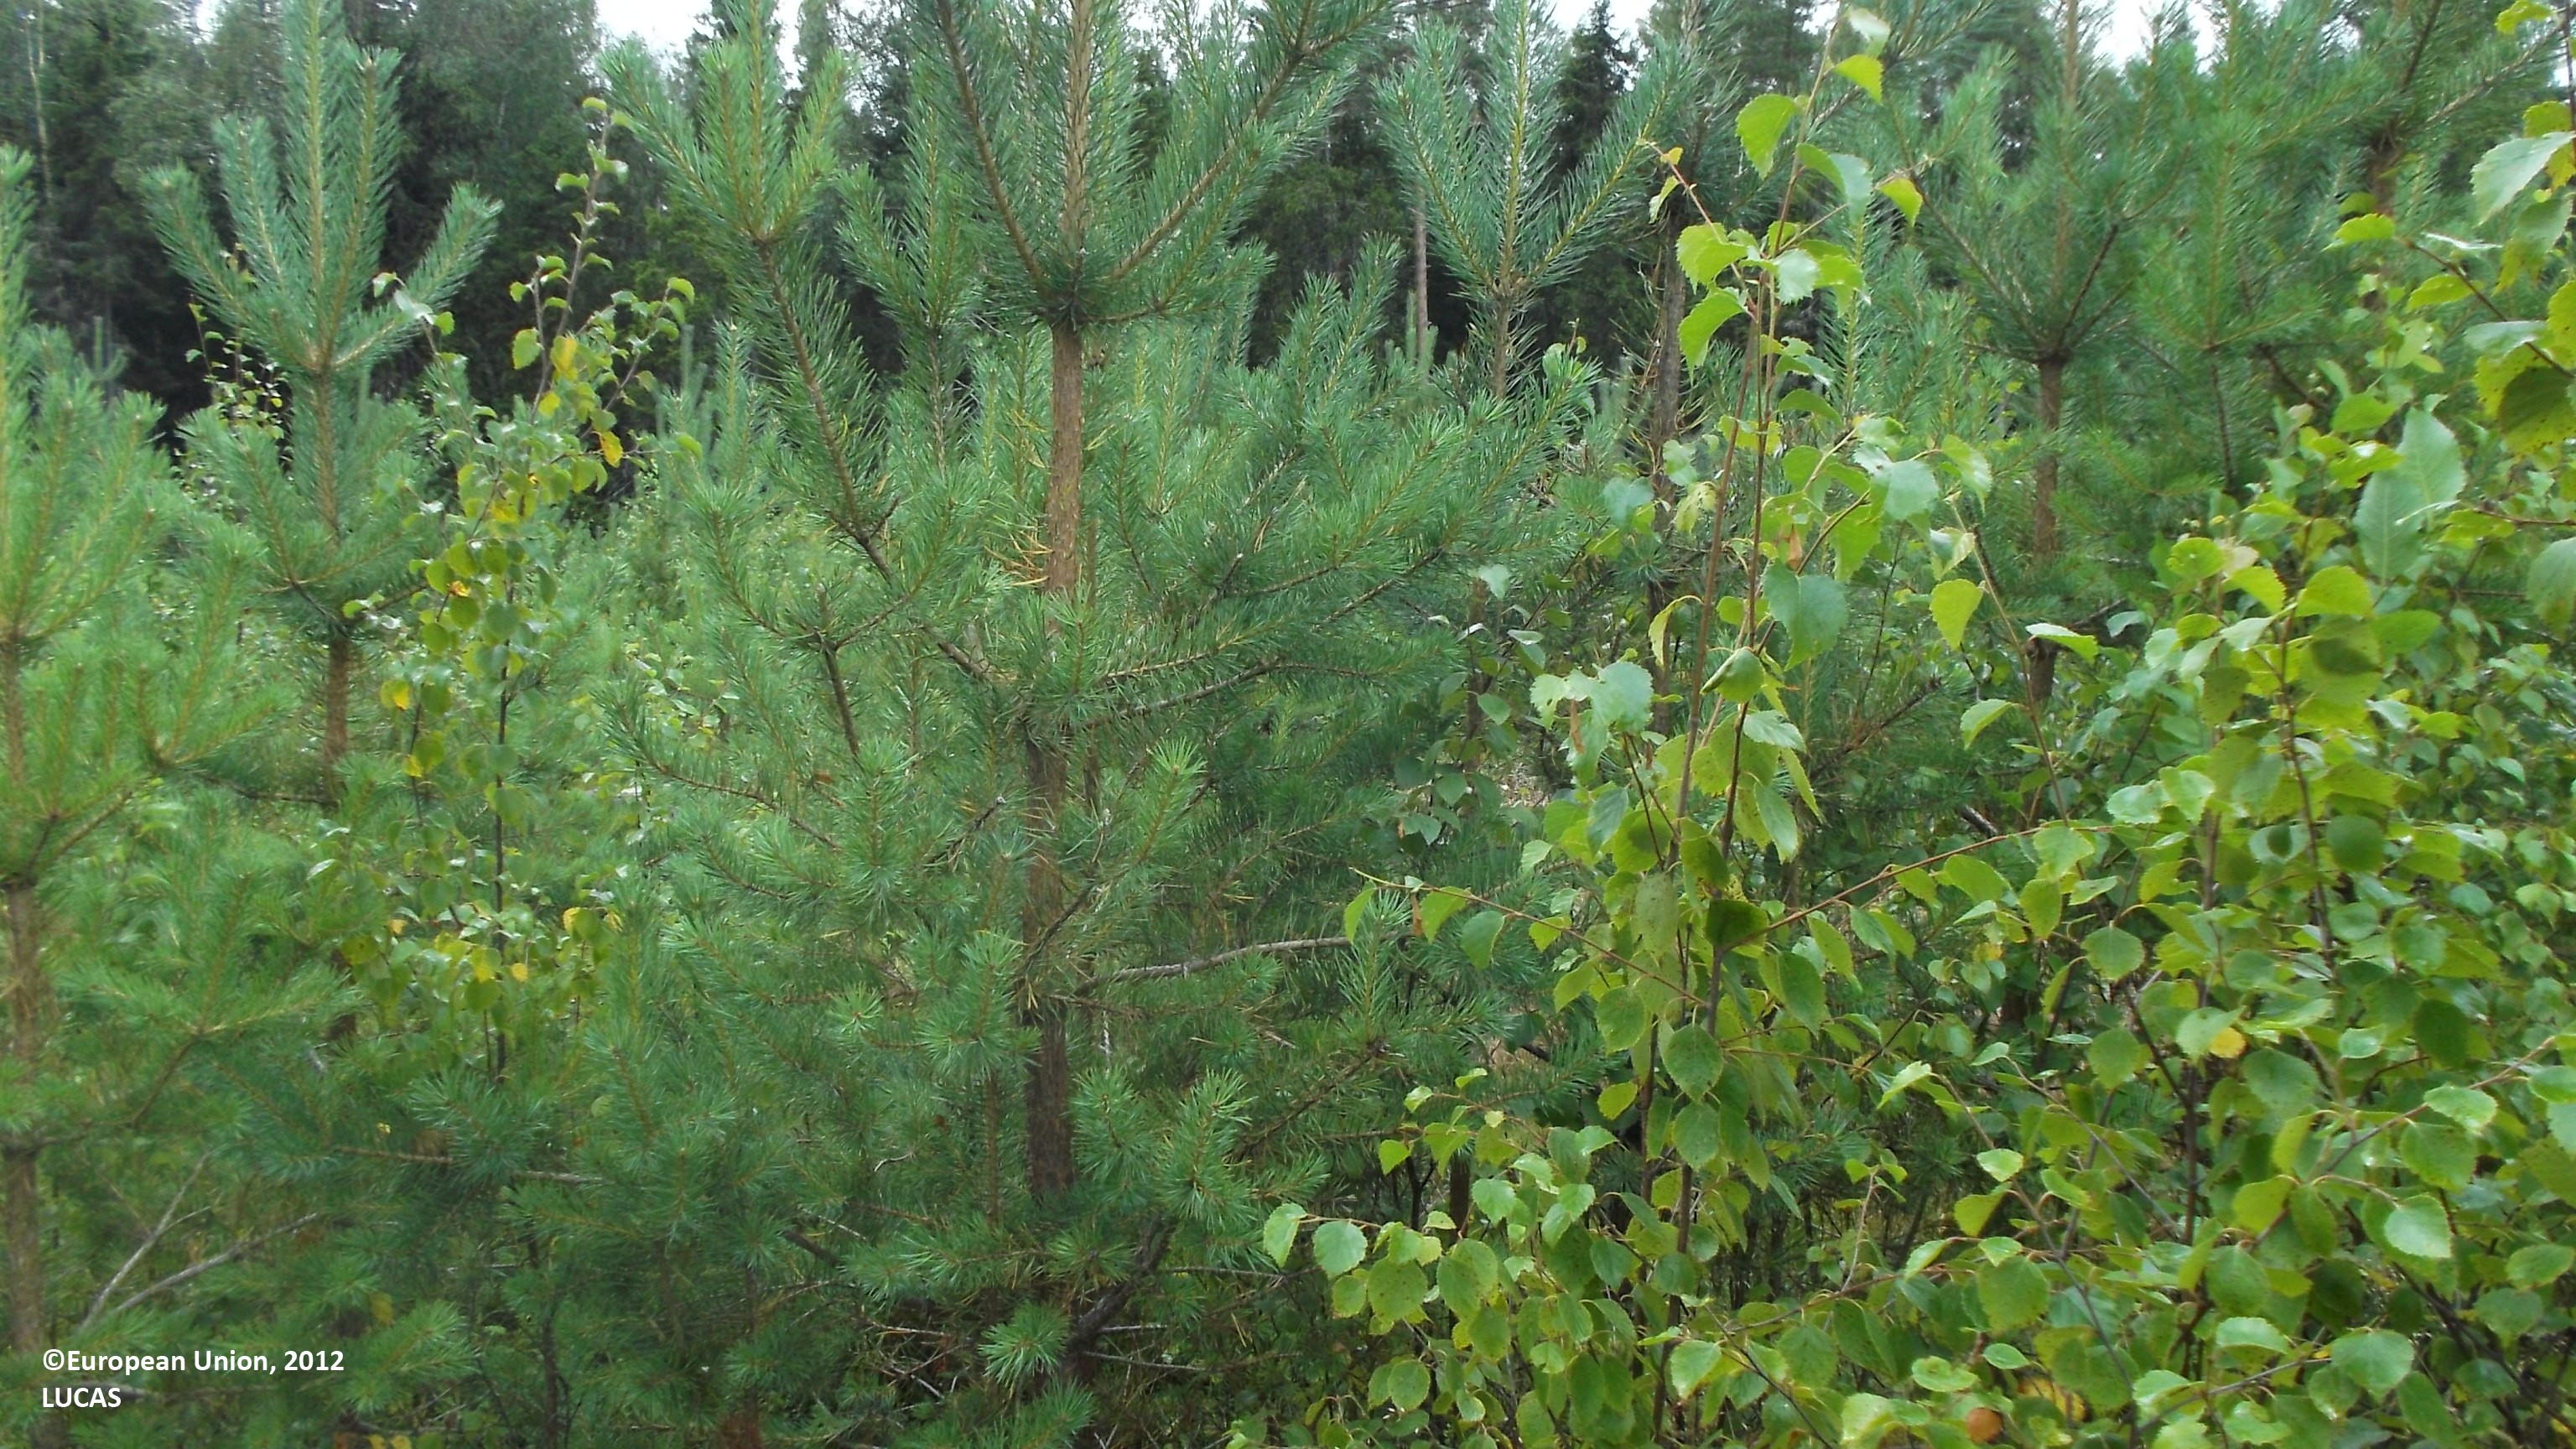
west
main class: Woodland
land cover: Other mixed woodland
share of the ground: 25 - 50 %
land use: Forestry
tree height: < 5 m
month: August
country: FI
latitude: 63.9216
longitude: 23.5768
